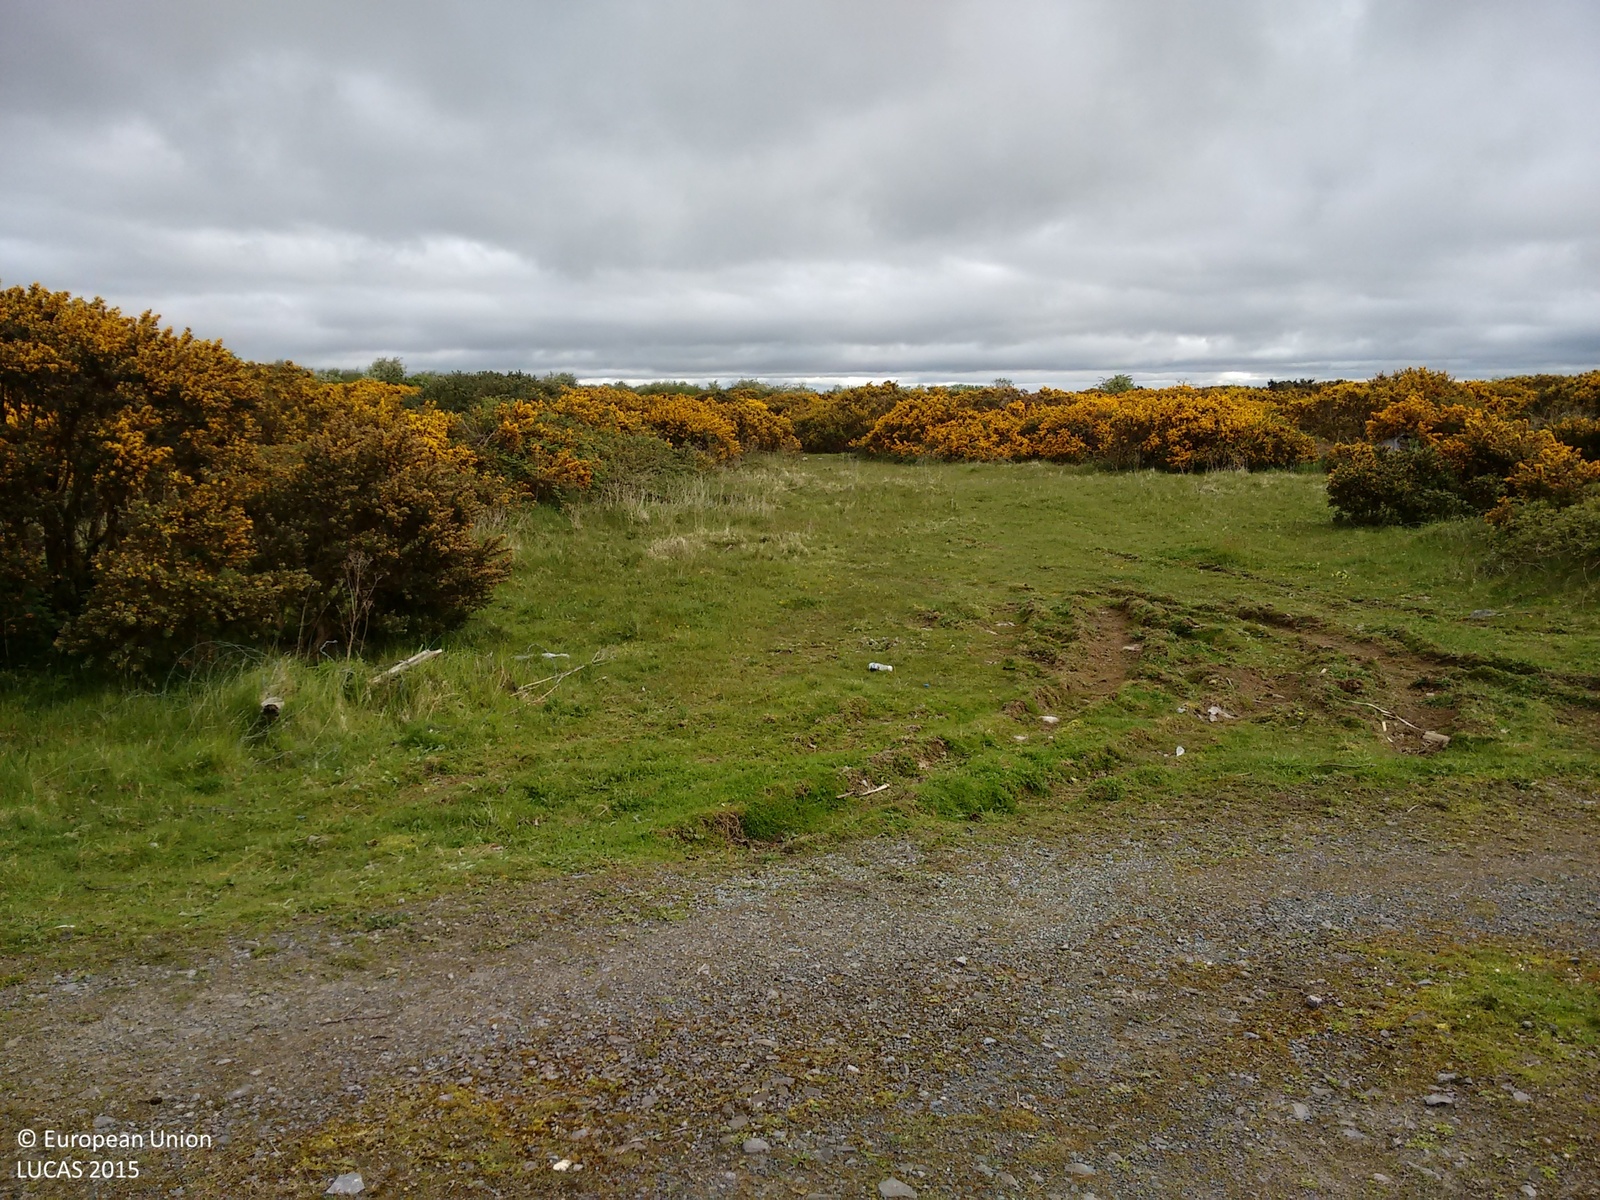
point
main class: Shrubland
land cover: Shrubland without tree cover
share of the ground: > 75 %
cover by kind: herbaceous plants 70 %, shrubs 30 %
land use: Semi-natural and natural areas not in use
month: May
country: IE
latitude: 53.3041
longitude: -8.9849
